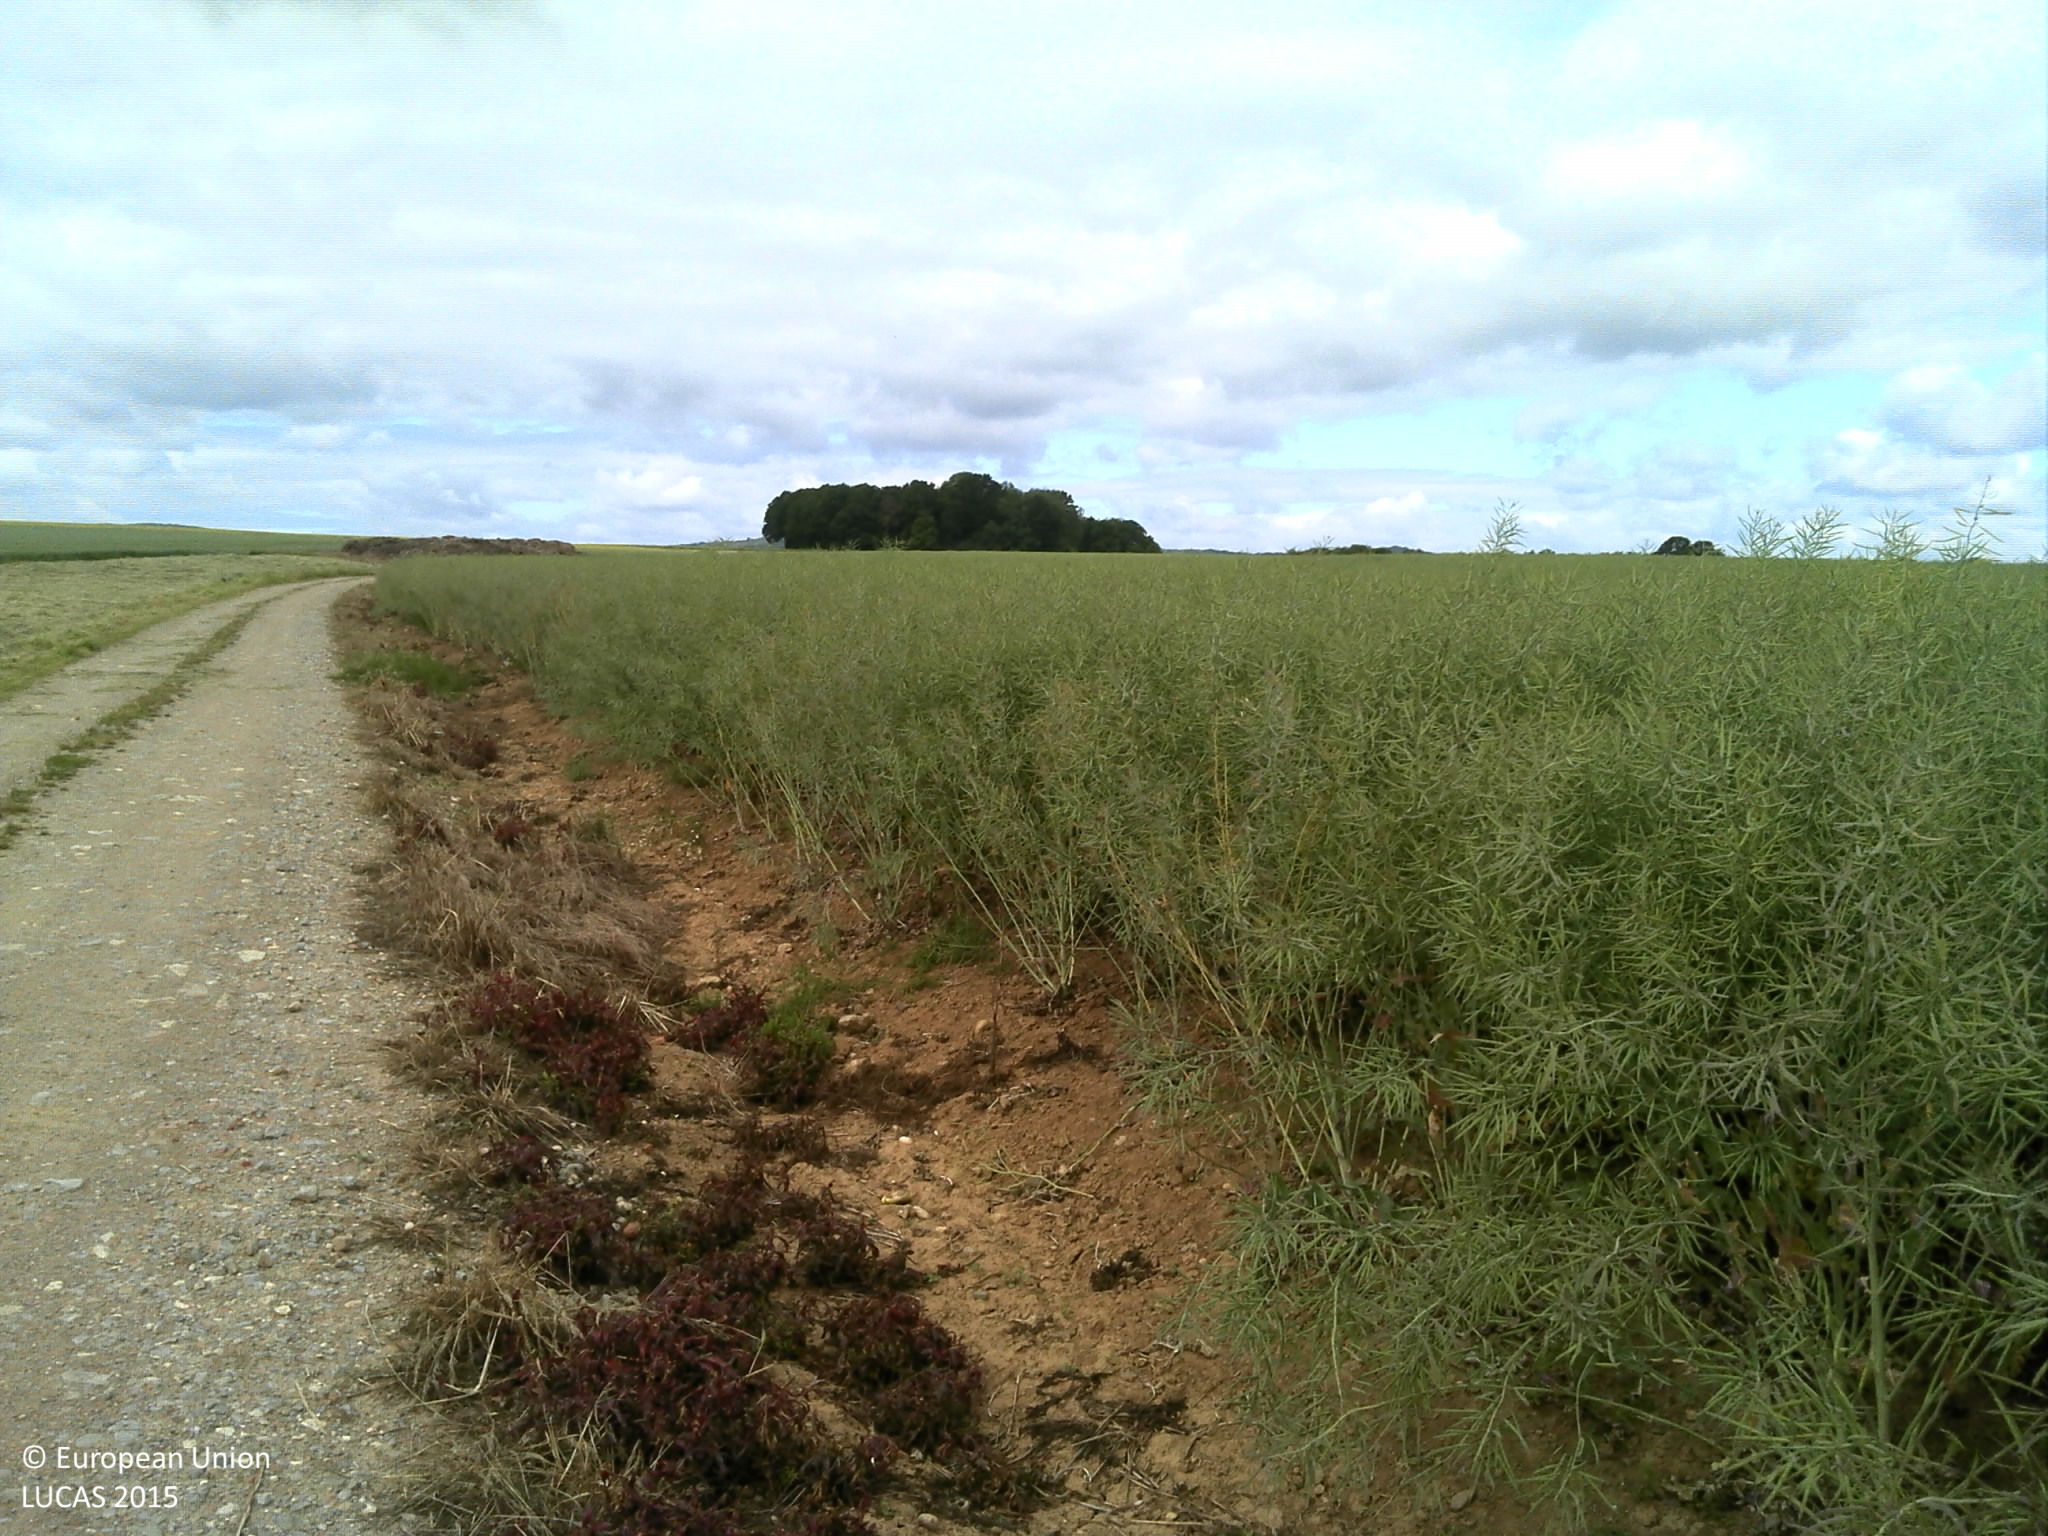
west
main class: Cropland
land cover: Rape and turnip rape
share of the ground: > 75 %
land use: Agriculture (excluding fallow land and kitchen gardens)
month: June
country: FR
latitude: 49.0032
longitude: 6.1586
